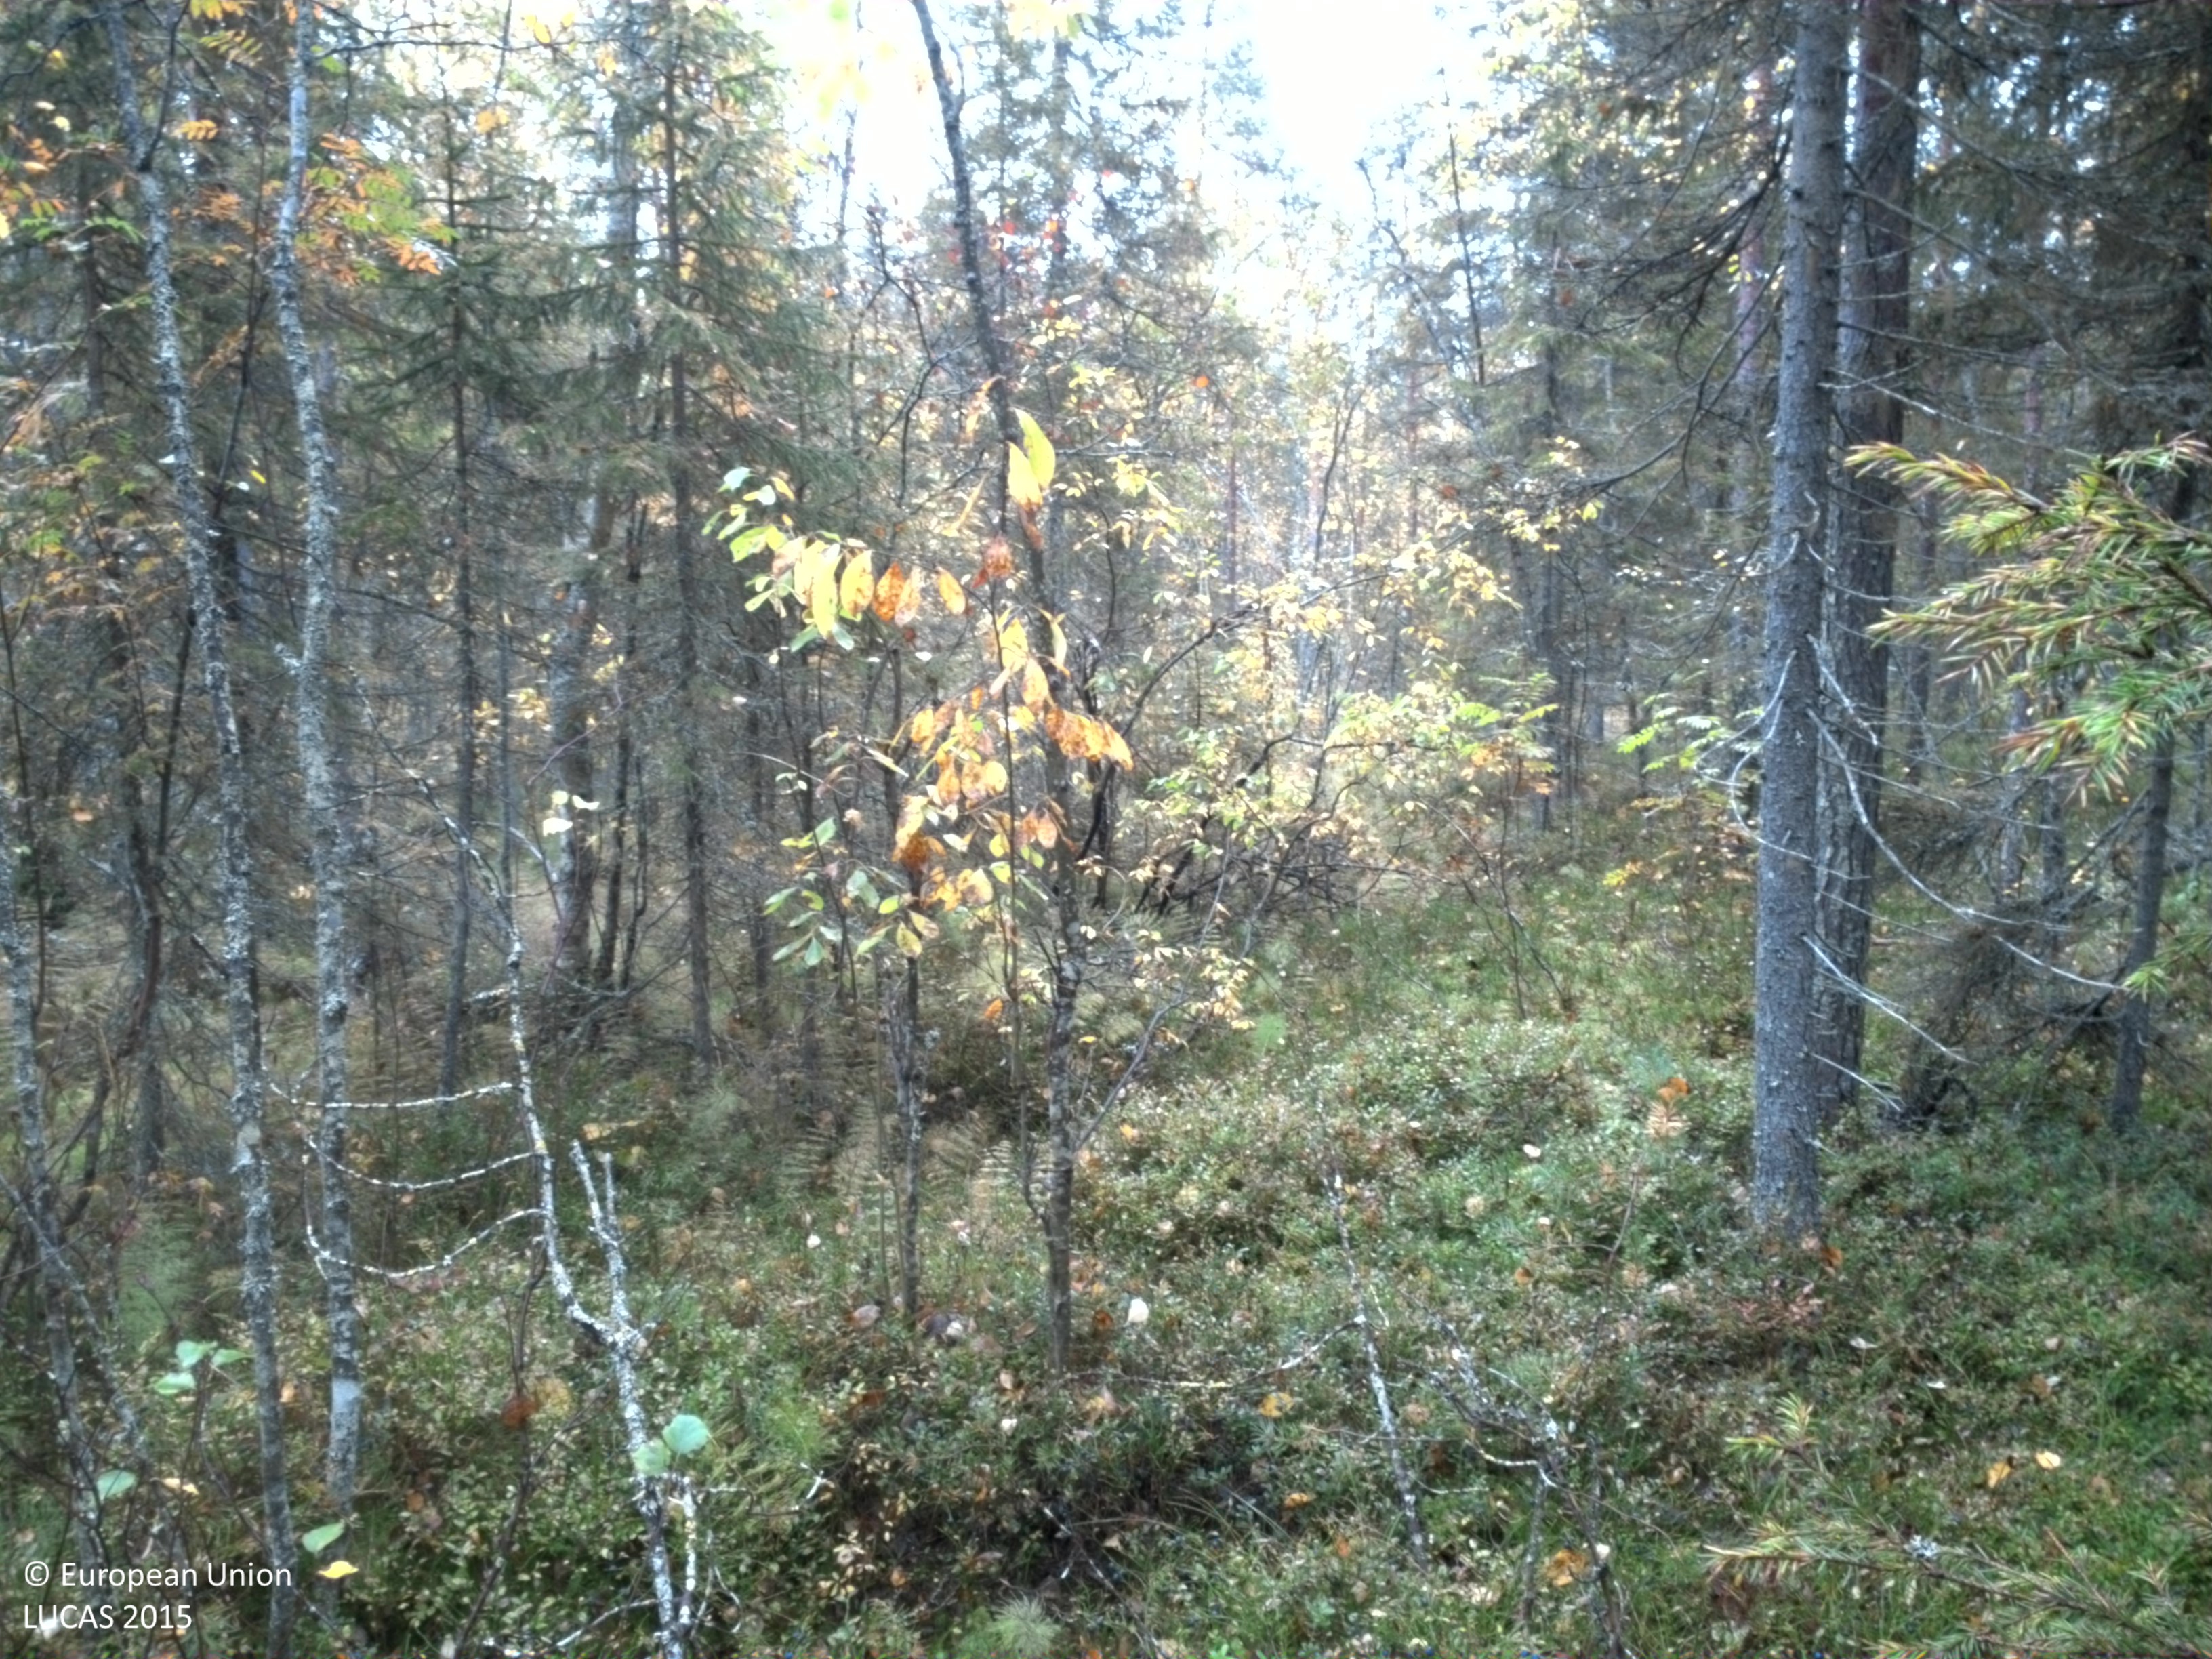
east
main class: Woodland
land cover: Other mixed woodland
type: boreal forest
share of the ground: 25 - 50 %
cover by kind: shrubs 45 %, coniferous forest trees 30 %, broadleaved forest trees 20 %, lichens and mosses 5 %
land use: Forestry
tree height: > 5 m
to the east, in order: Other mixed woodland; Grassland with sparse tree/shrub cover; Electric lines; Grassland with sparse tree/shrub cover; Other mixed woodland; Pine dominated coniferous woodland; Pine dominated mixed woodland
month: September
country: SE
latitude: 65.9003
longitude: 22.0237
